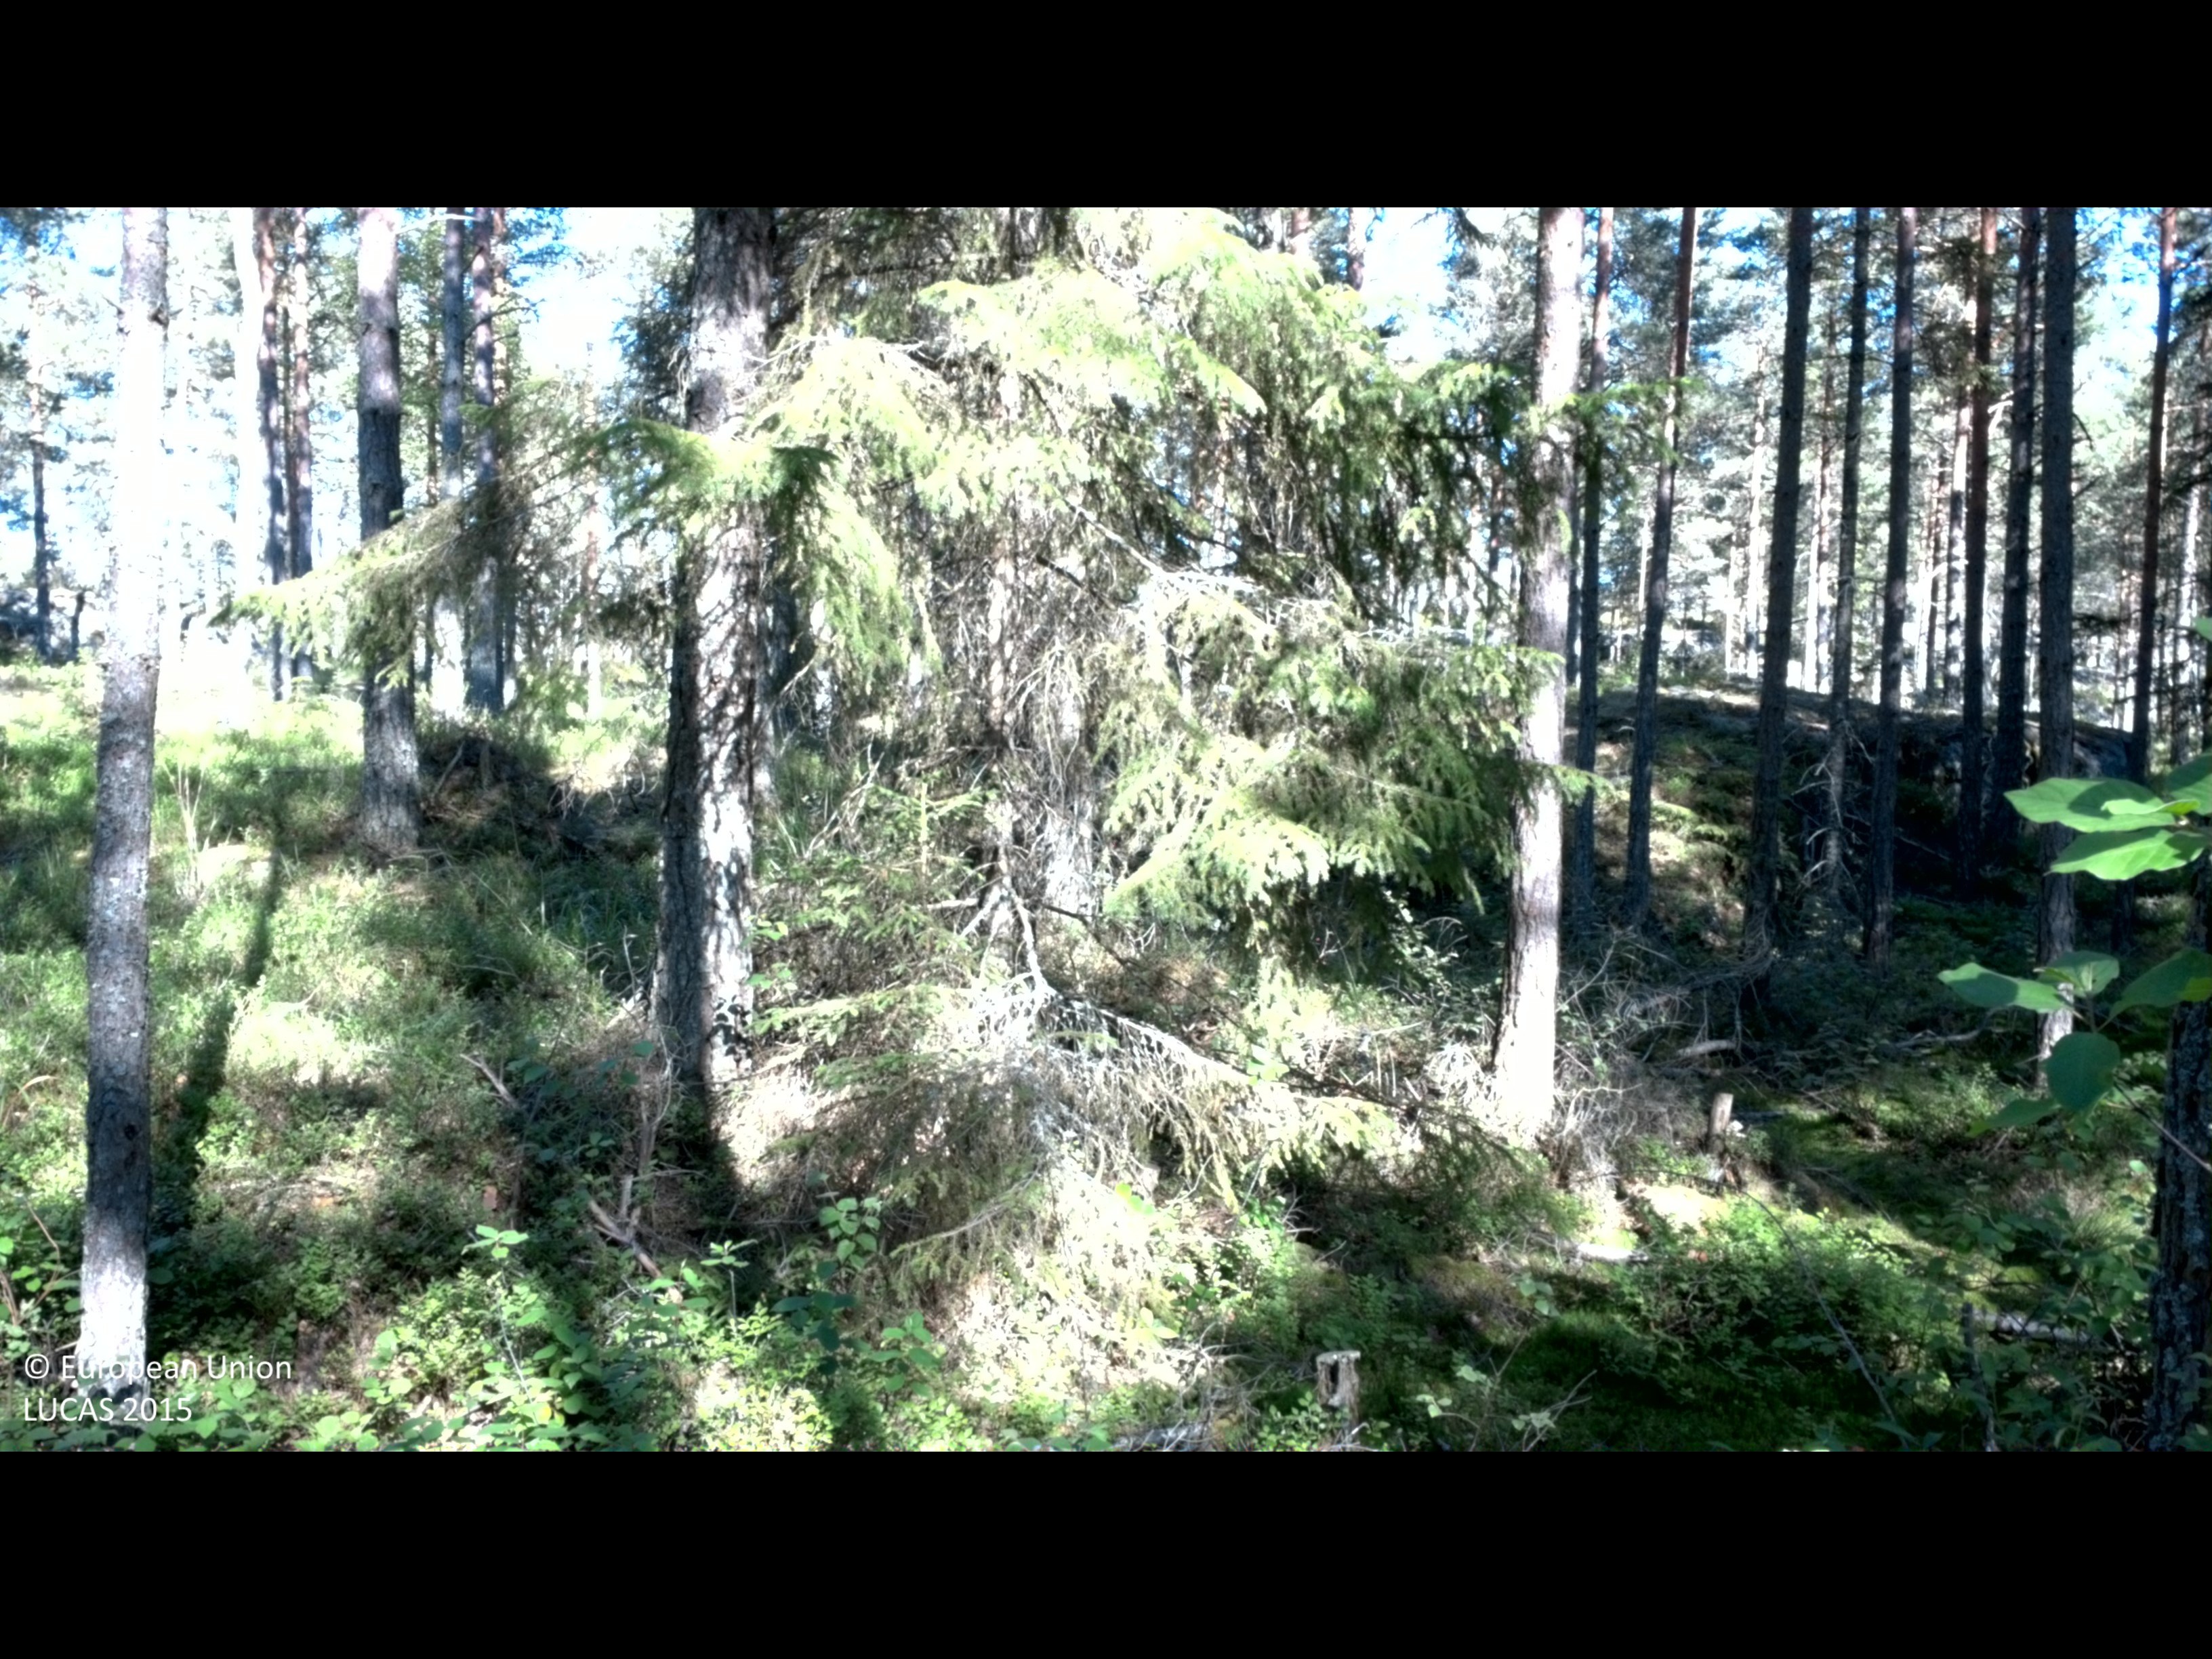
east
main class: Woodland
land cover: Pine dominated mixed woodland
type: boreal forest
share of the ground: 50 - 75 %
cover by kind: coniferous forest trees 50 %, shrubs 25 %, broadleaved forest trees 20 %, herbaceous plants 5 %
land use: Forestry
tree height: > 5 m
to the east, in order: Pine dominated mixed woodland; Pine dominated coniferous woodland; Pine dominated mixed woodland; Pine dominated coniferous woodland
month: July
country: SE
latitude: 58.2351
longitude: 16.6566
